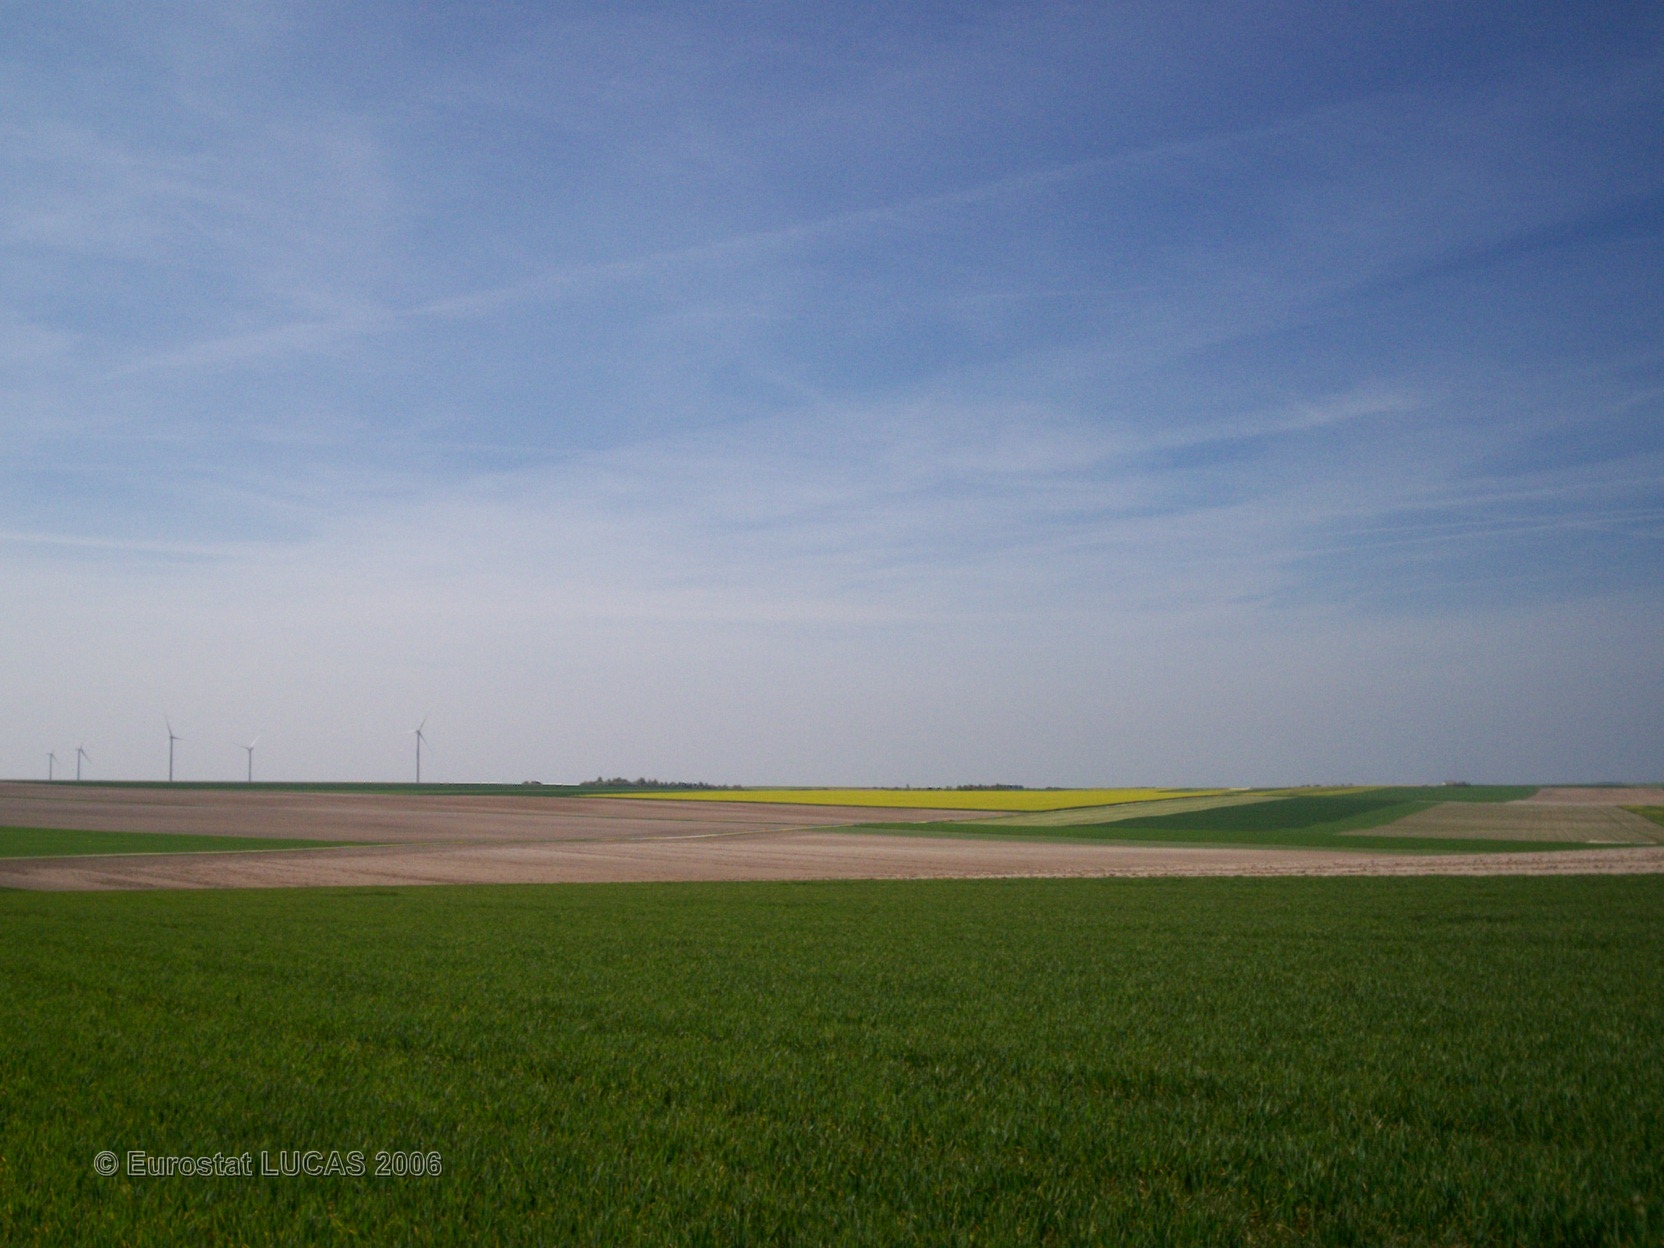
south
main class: Cropland
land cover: Common wheat
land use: Agriculture (excluding fallow land and kitchen gardens)
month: May
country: FR
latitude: 48.8565
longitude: 4.3947
